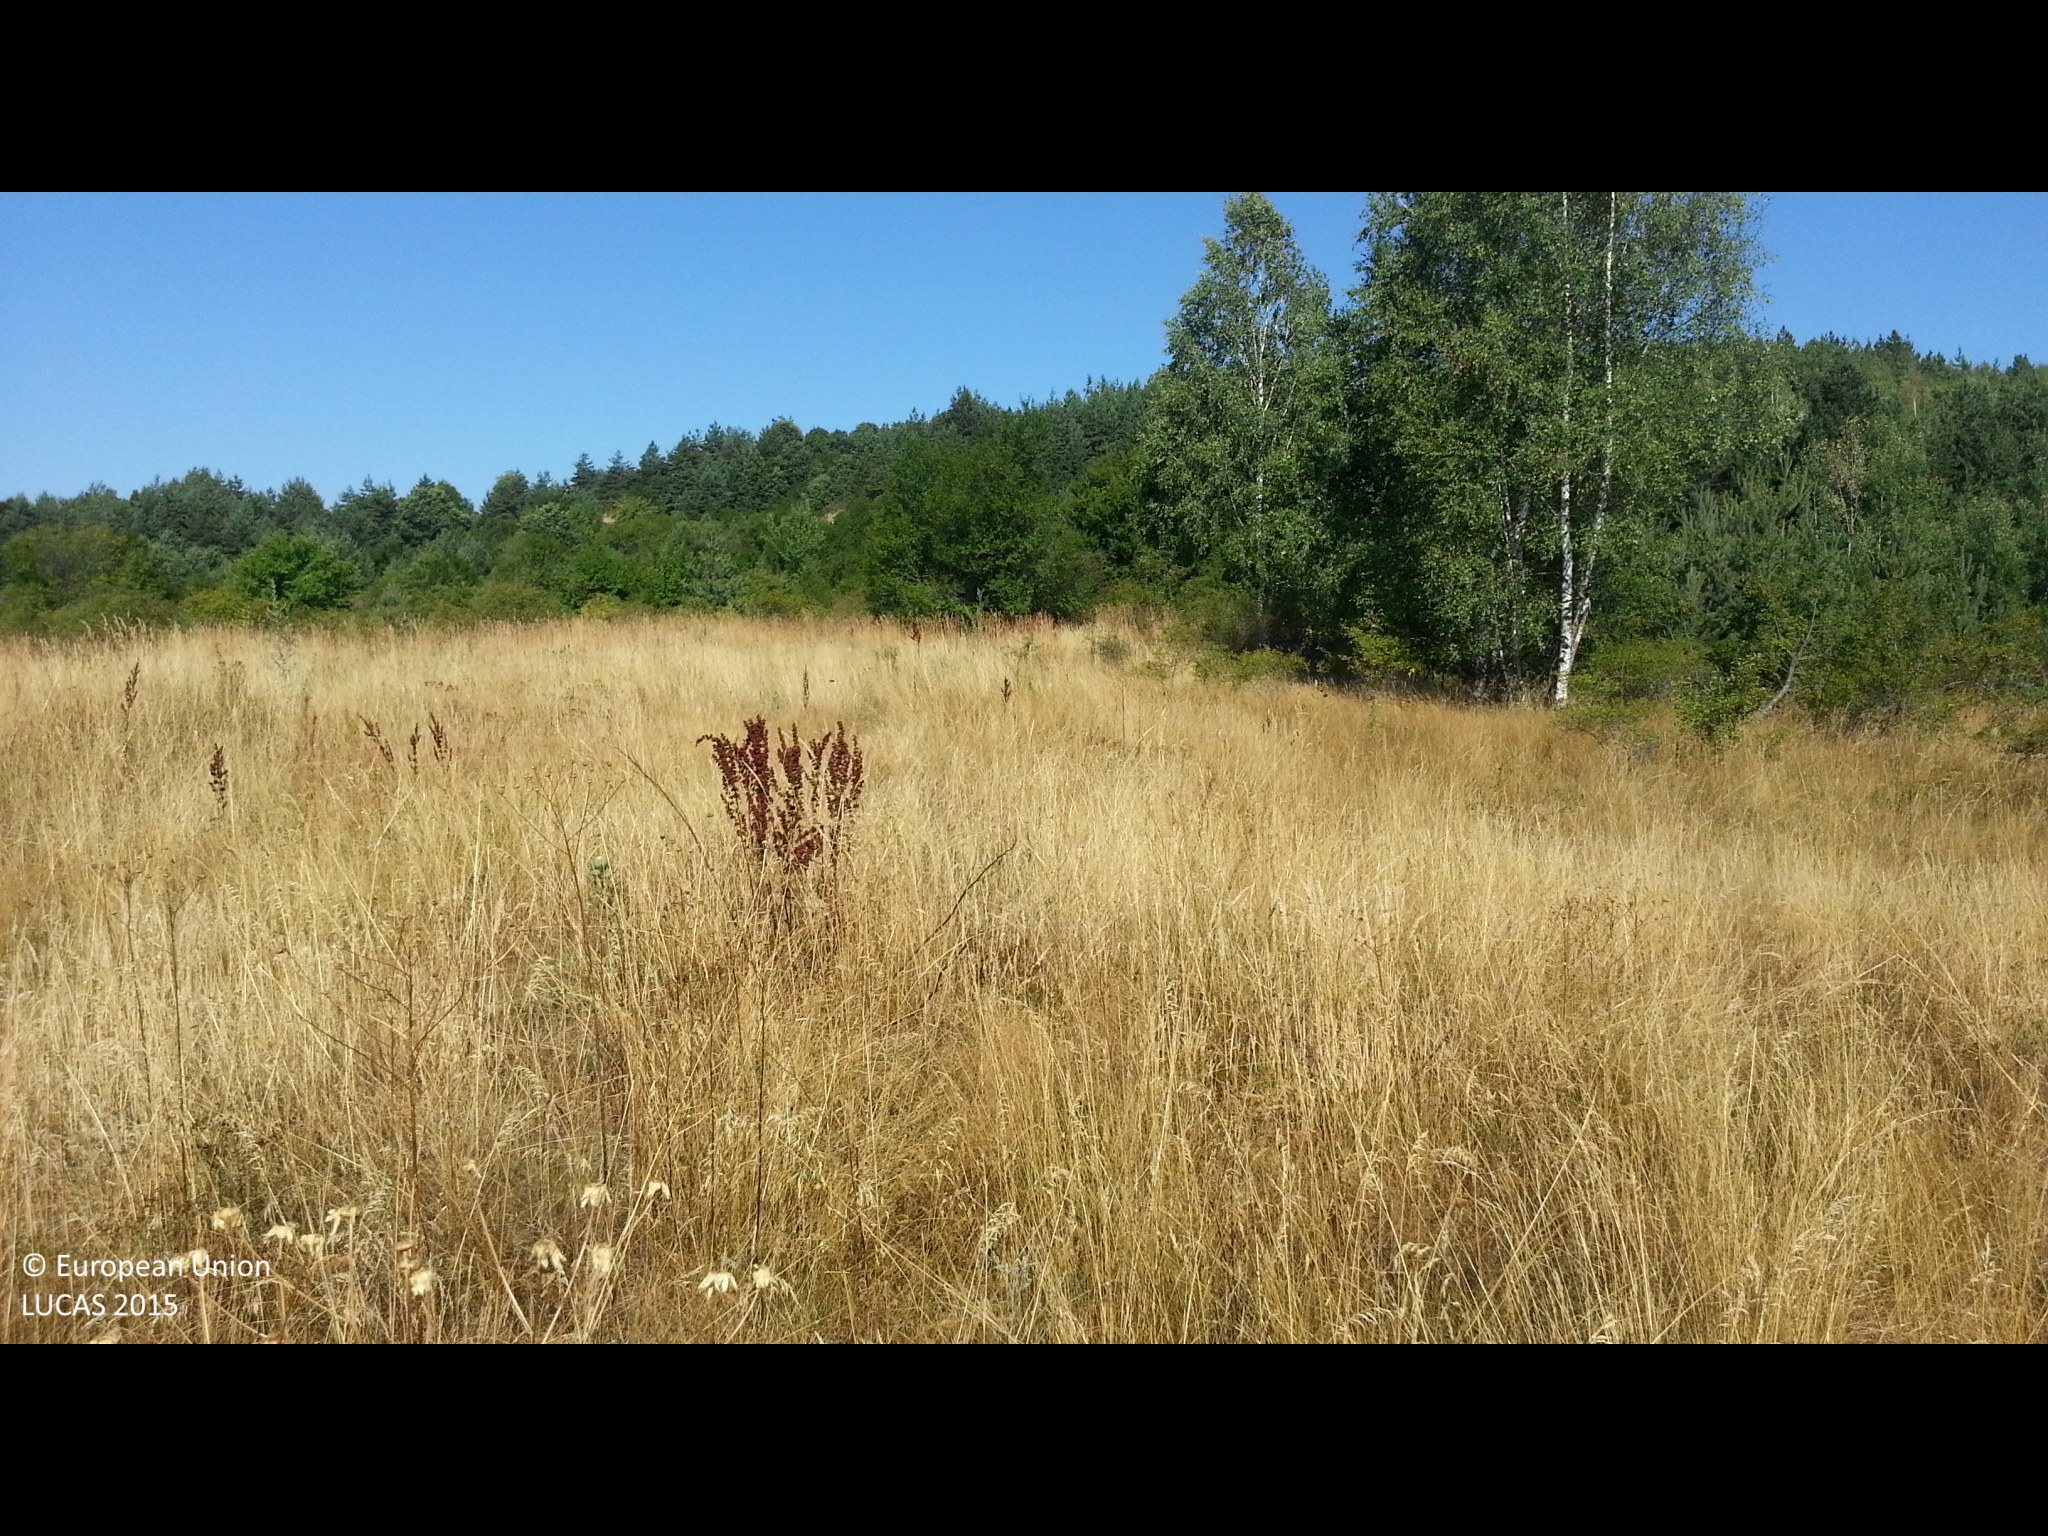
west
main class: Grassland
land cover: Grassland with sparse tree/shrub cover
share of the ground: > 75 %
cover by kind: herbaceous plants 90 %, broadleaved forest trees 5 %, shrubs 5 %
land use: Agriculture (excluding fallow land and kitchen gardens)
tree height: > 5 m
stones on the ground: < 10 %
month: August
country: BG
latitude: 42.2694
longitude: 22.5685
